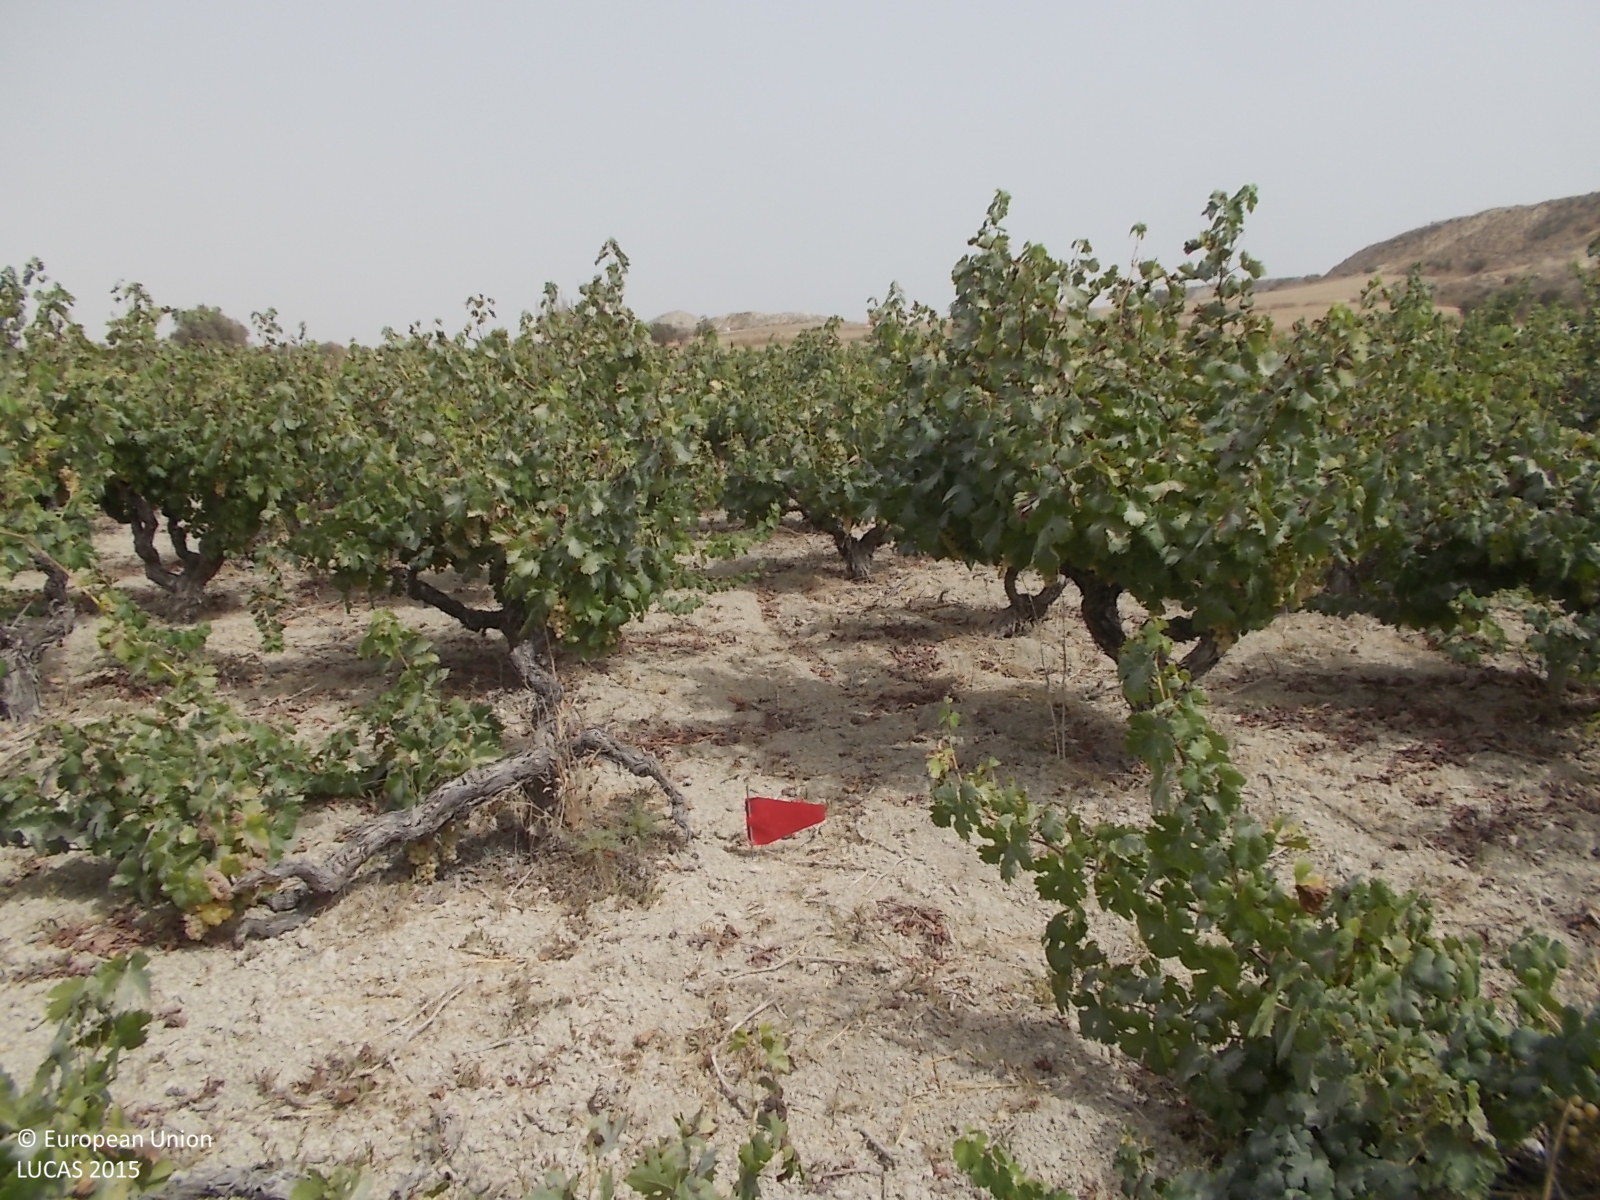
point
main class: Cropland
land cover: Vineyards
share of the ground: > 75 %
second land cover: Other bare soil
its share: > 75 %
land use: Agriculture (excluding fallow land and kitchen gardens)
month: April
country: CY
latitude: 34.8070
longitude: 33.4580
